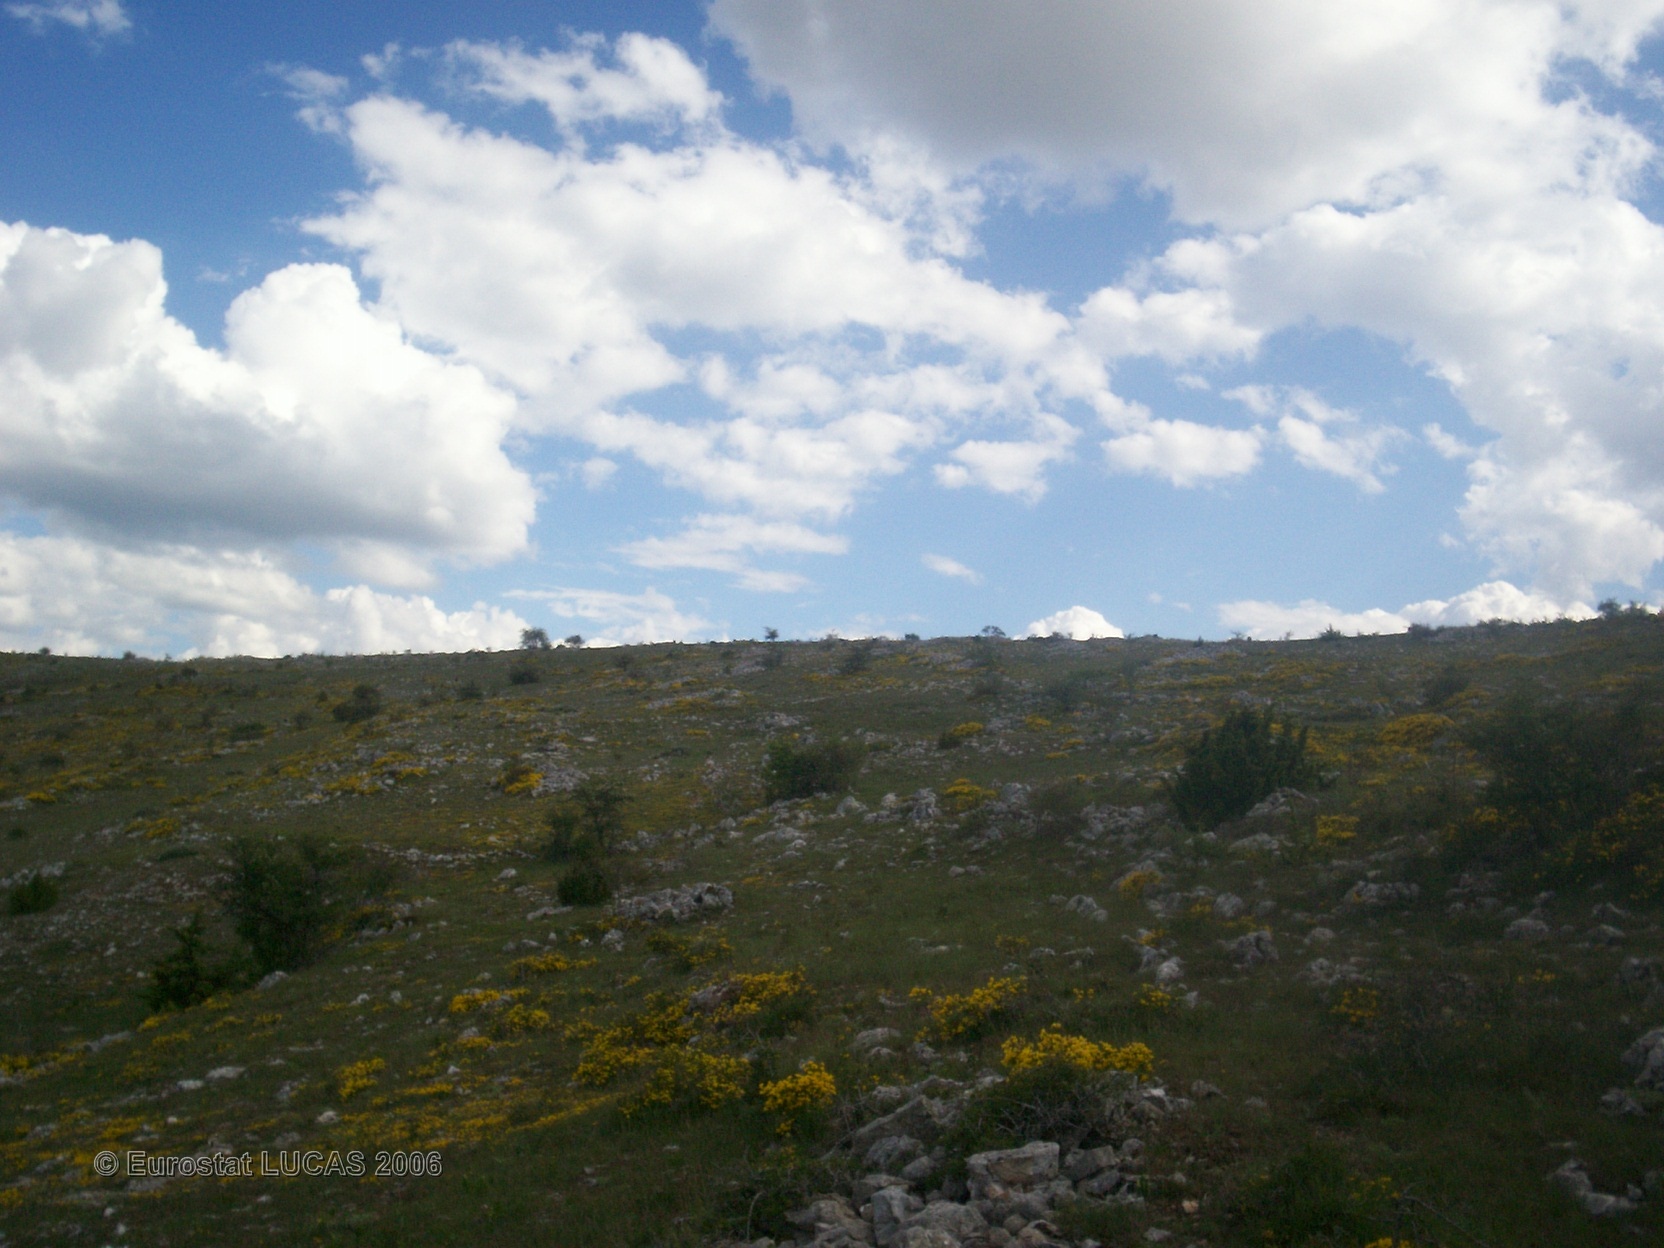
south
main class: Grassland
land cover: Grassland without tree/shrub cover
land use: Agriculture (excluding fallow land and kitchen gardens)
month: June
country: FR
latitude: 44.2525
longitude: 3.4560
